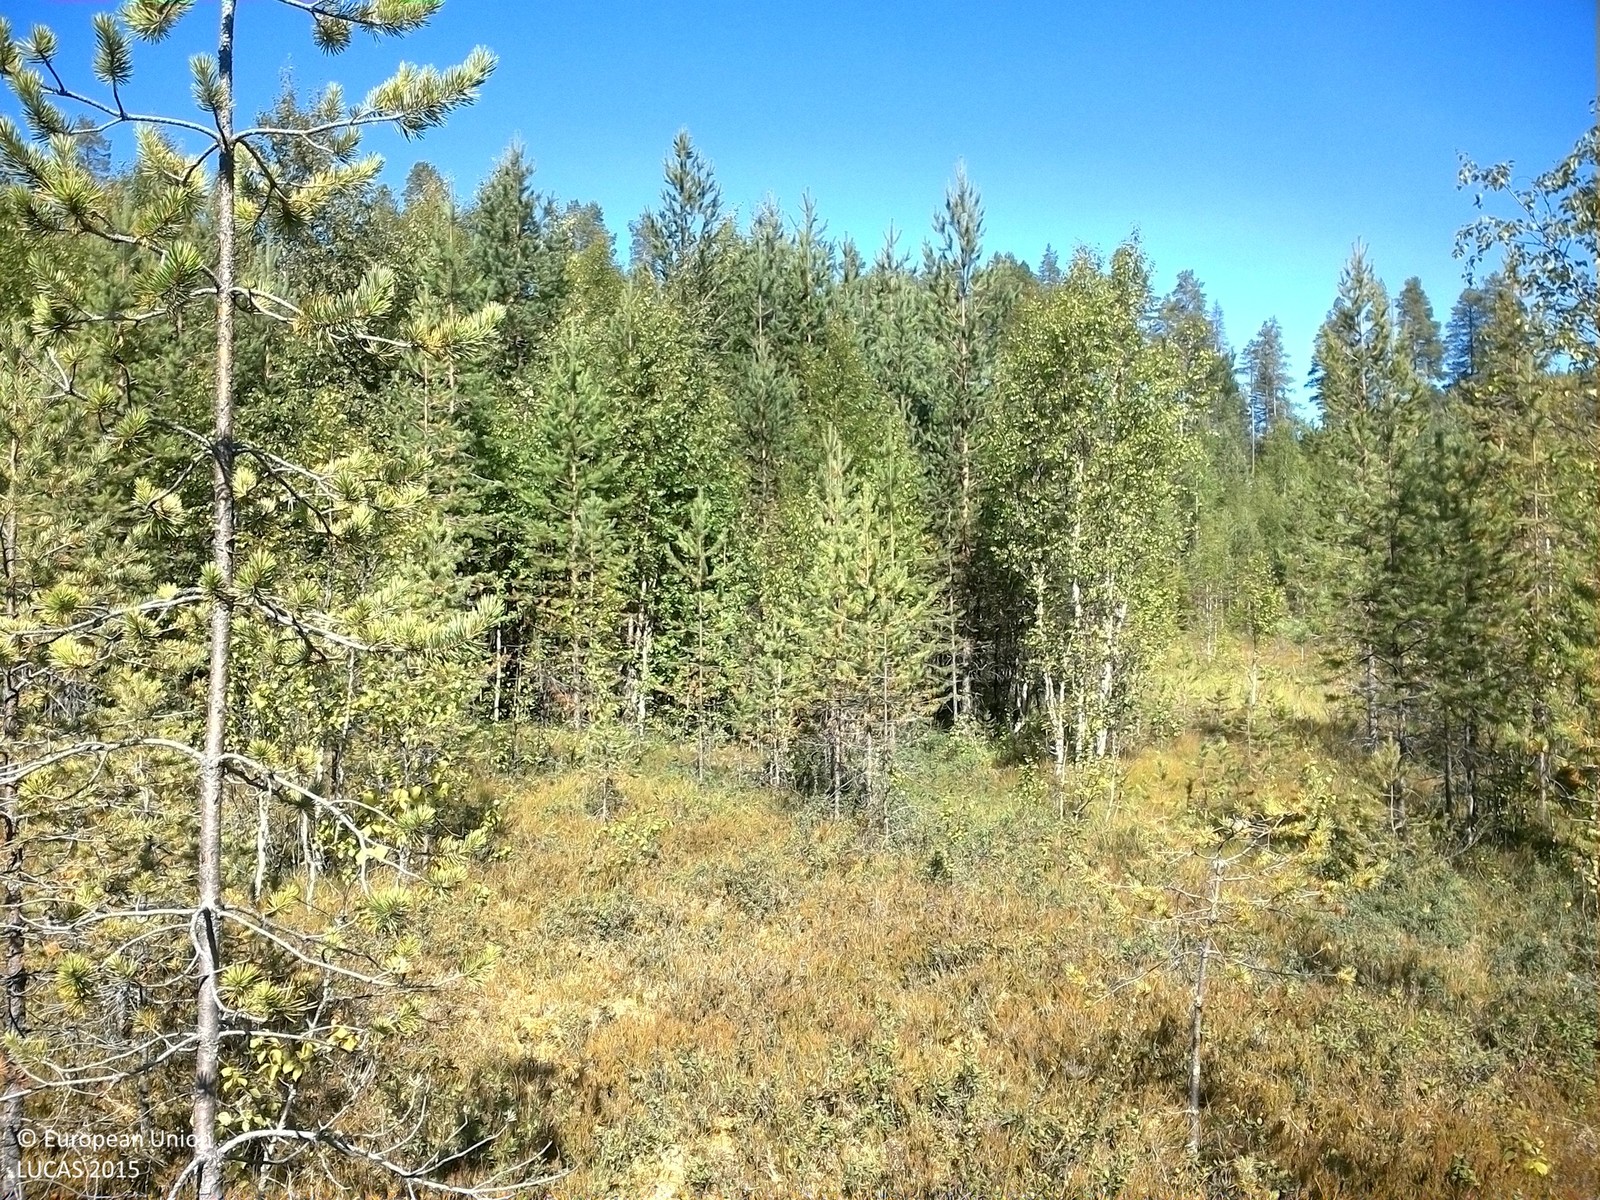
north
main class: Woodland
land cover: Pine dominated coniferous woodland
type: boreal forest
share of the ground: 10 - 25 %
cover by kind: shrubs 50 %, coniferous forest trees 20 %, lichens and mosses 15 %, herbaceous plants 10 %, broadleaved forest trees 5 %
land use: Semi-natural and natural areas not in use
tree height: < 5 m
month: August
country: SE
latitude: 63.7317
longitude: 17.8509
